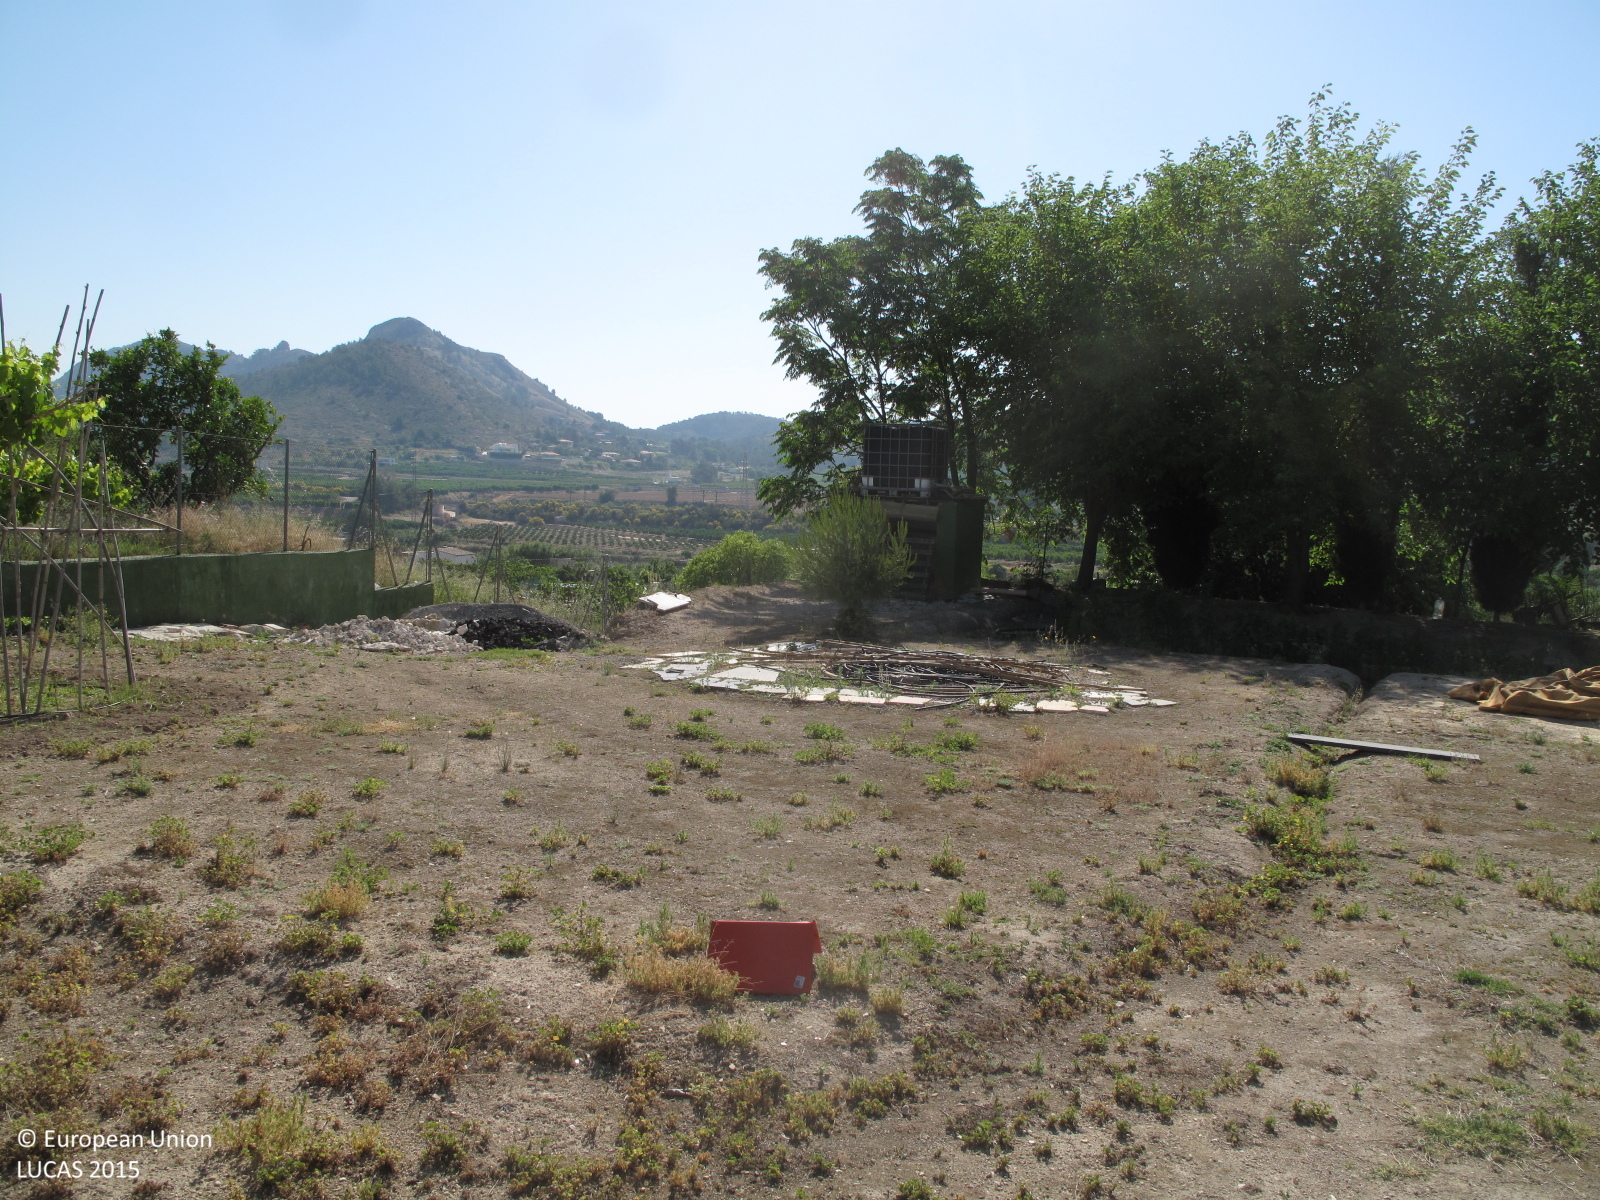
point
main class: Grassland
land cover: Spontaneously vegetated surfaces
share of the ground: 10 - 25 %
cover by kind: unconsolidated bare surface 90 %, herbaceous plants 10 %
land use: Residential
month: May
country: ES
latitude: 38.9644
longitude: -0.5757
